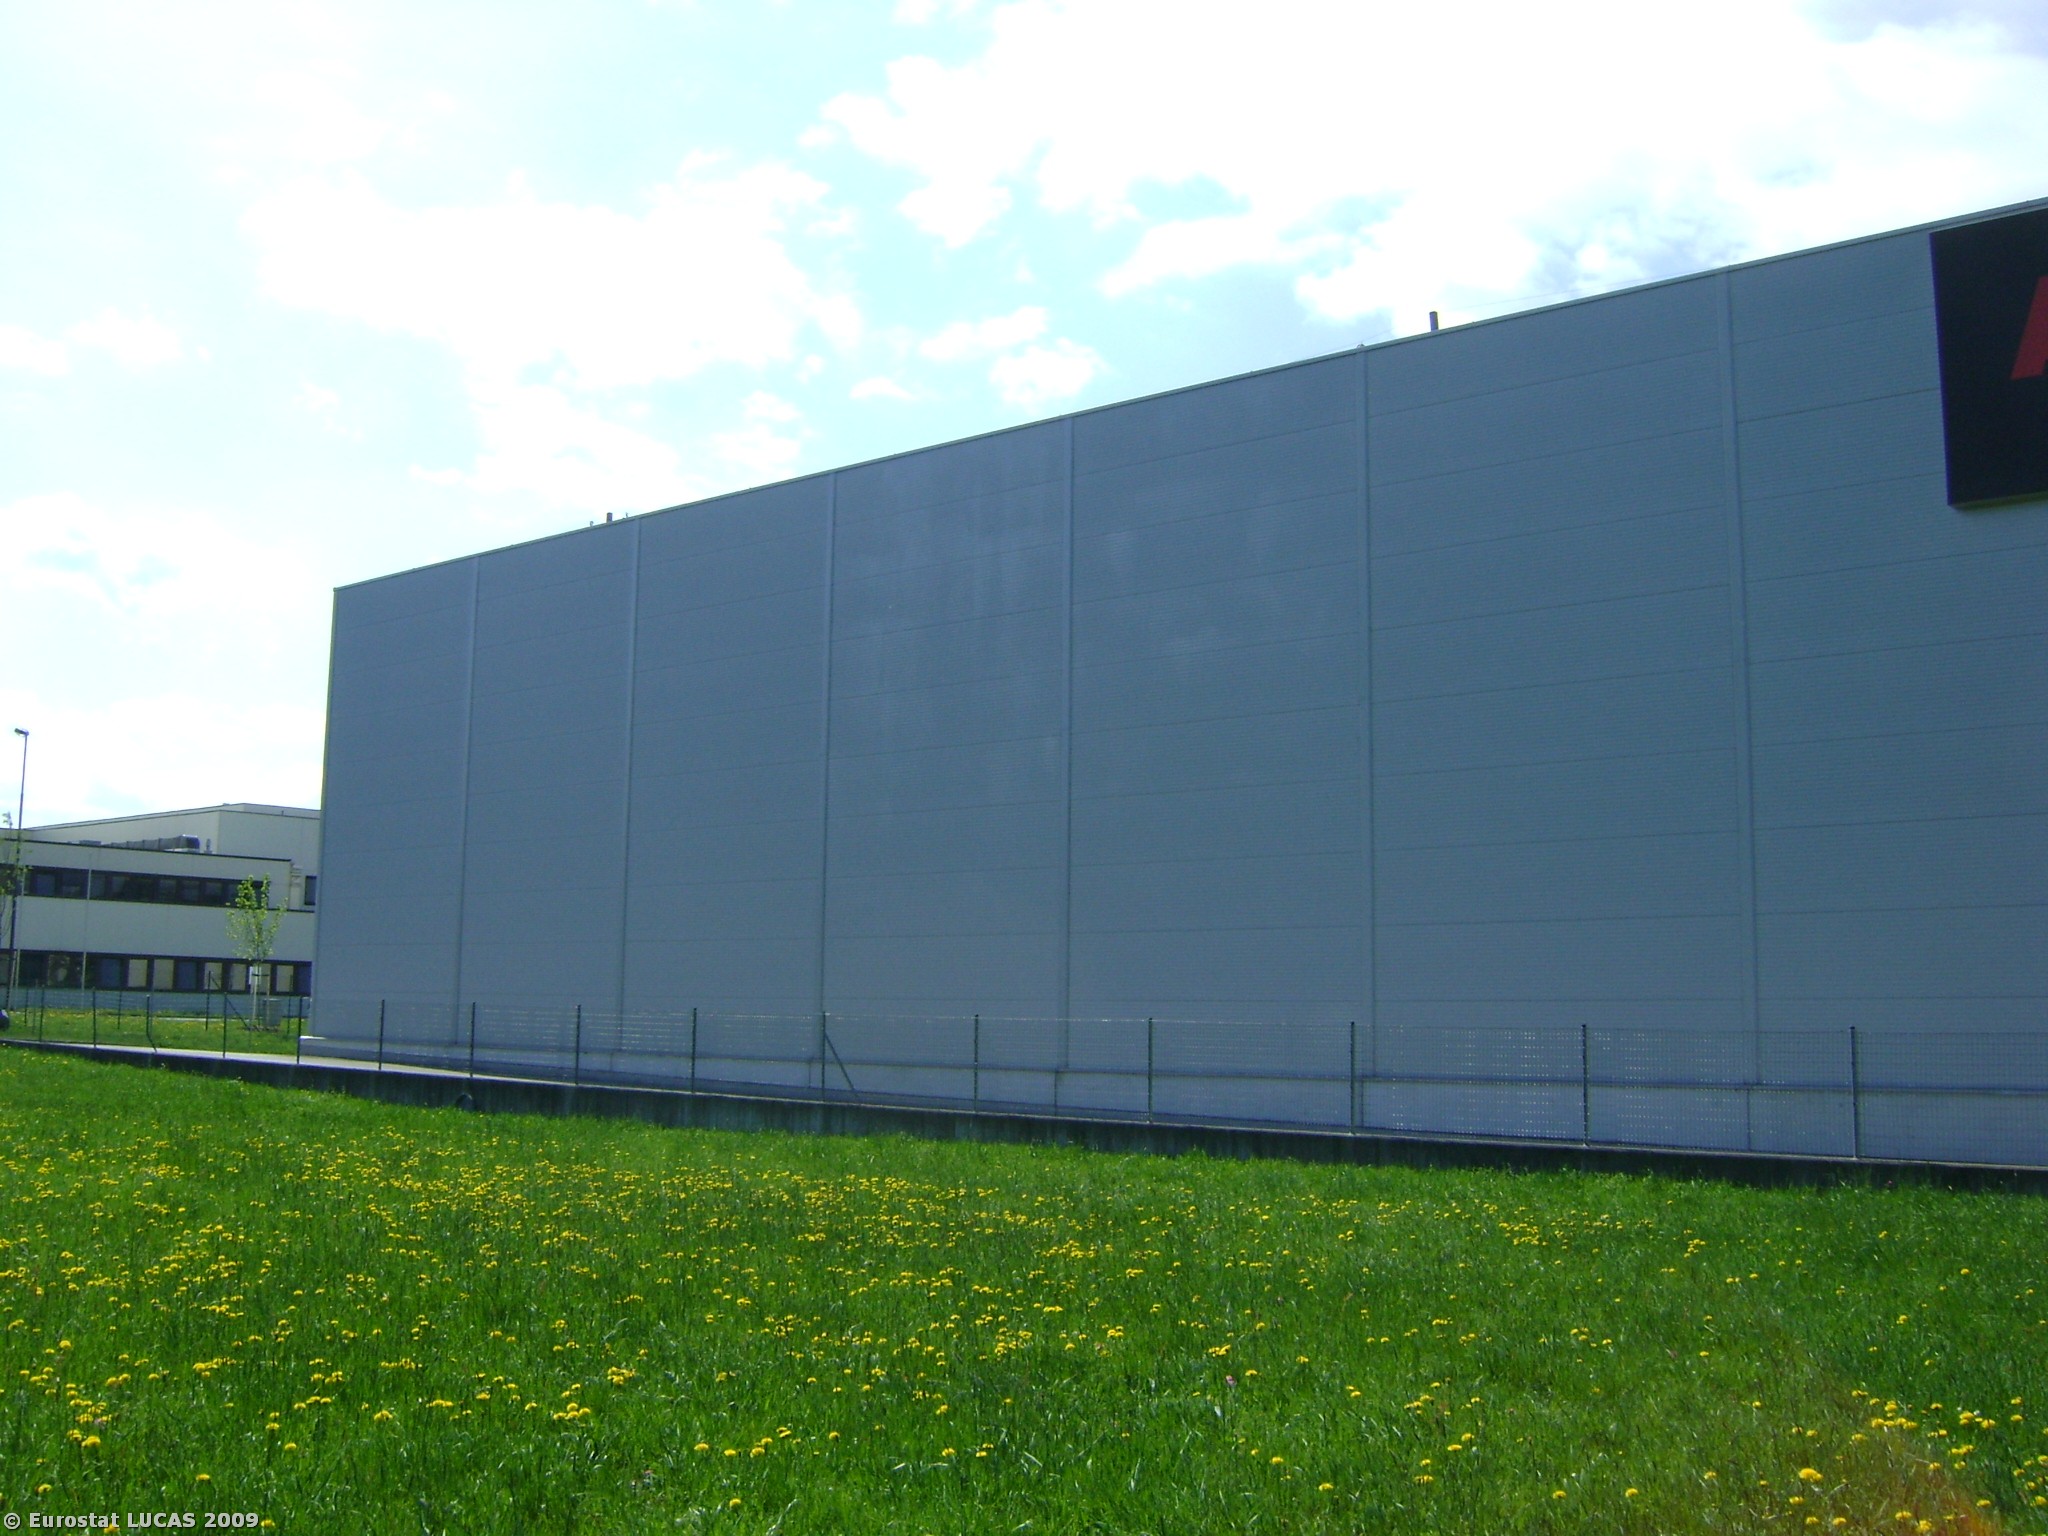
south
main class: Grassland
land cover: Grassland without tree/shrub cover
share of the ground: > 75 %
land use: Agriculture (excluding fallow land and kitchen gardens)
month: May
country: AT
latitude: 47.8524
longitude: 13.2196
